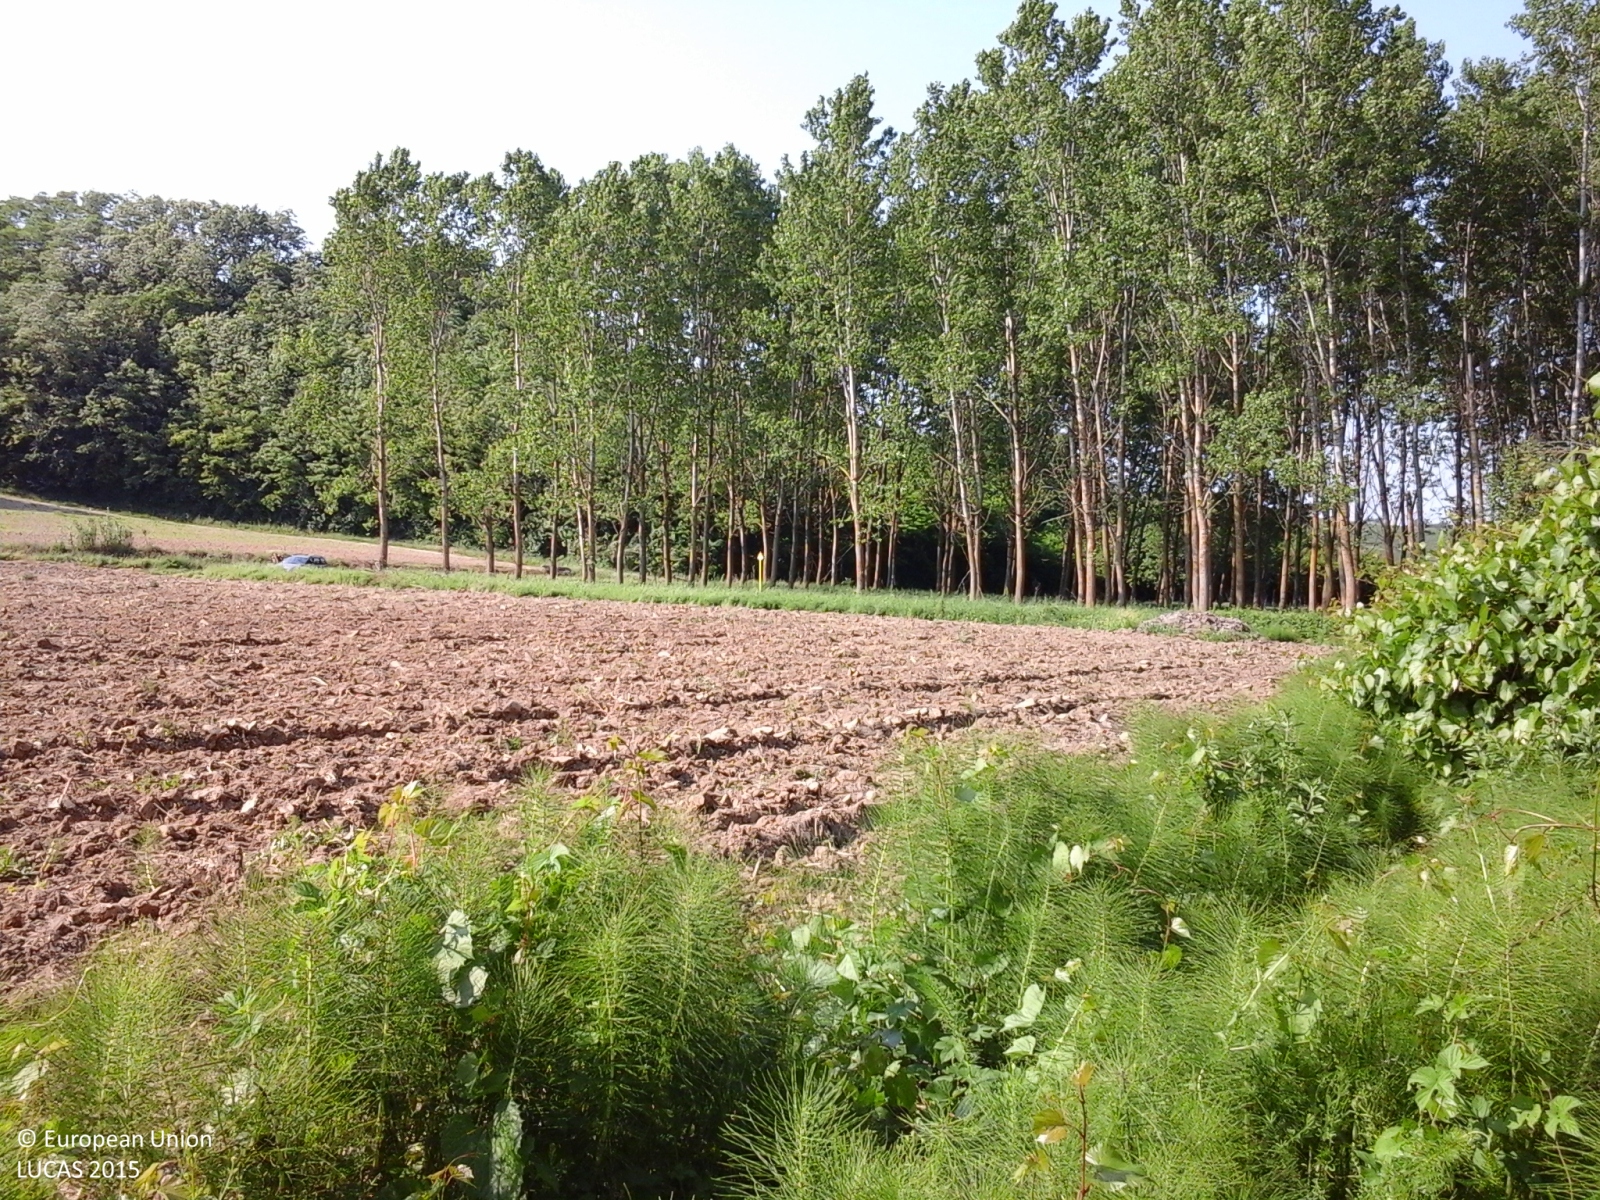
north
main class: Woodland
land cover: Broadleaved woodland
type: mesophytic deciduous forest
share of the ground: > 75 %
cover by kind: broadleaved forest trees 95 %, shrubs 5 %
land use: Forestry
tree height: > 5 m
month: May
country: IT
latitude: 44.7711
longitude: 8.3985
